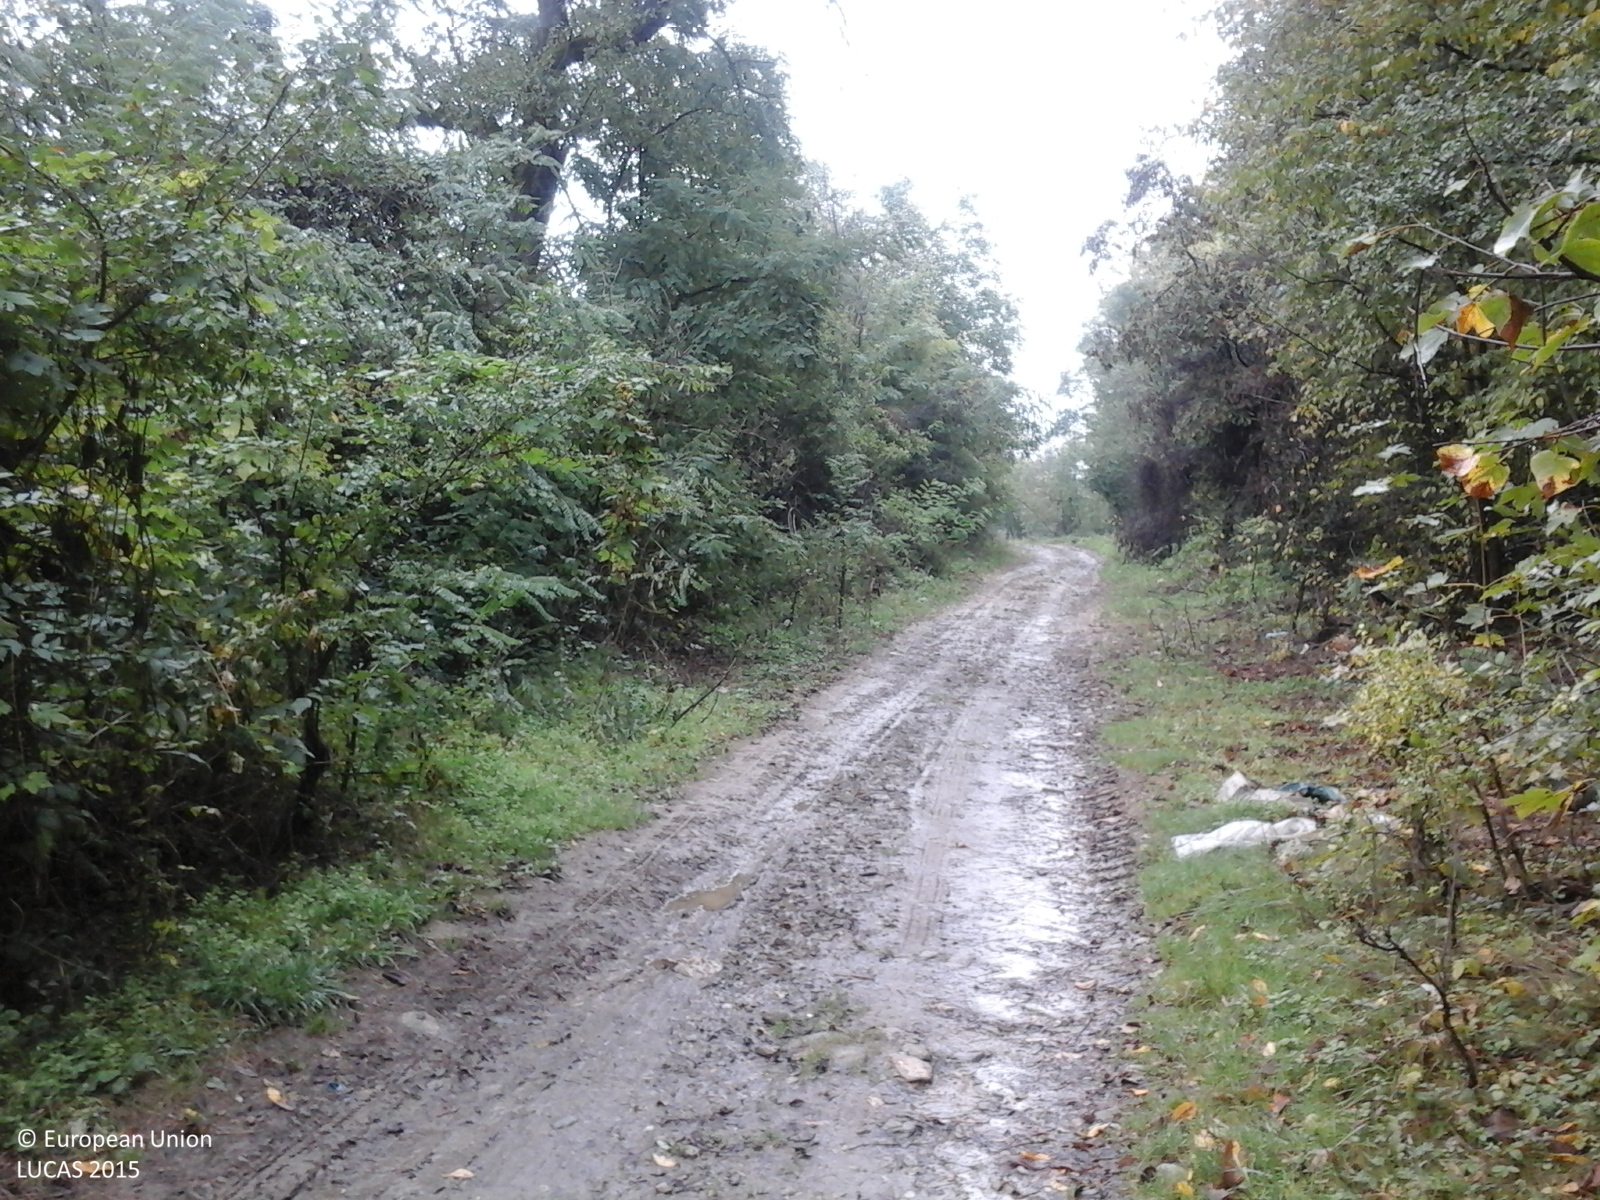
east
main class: Grassland
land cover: Grassland with sparse tree/shrub cover
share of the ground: > 75 %
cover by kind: herbaceous plants 95 %, broadleaved forest trees 5 %
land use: Agriculture (excluding fallow land and kitchen gardens)
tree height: > 5 m
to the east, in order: Grassland with sparse tree/shrub cover; Electric lines; Grassland without tree/shrub cover; Fences; Abandoned hedges; Tracks; Grass margins; Fences; Grassland without tree/shrub cover; Broadleaved woodland; Tracks; Broadleaved woodland; Grassland without tree/shrub cover
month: October
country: RO
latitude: 45.7209
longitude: 24.9032
